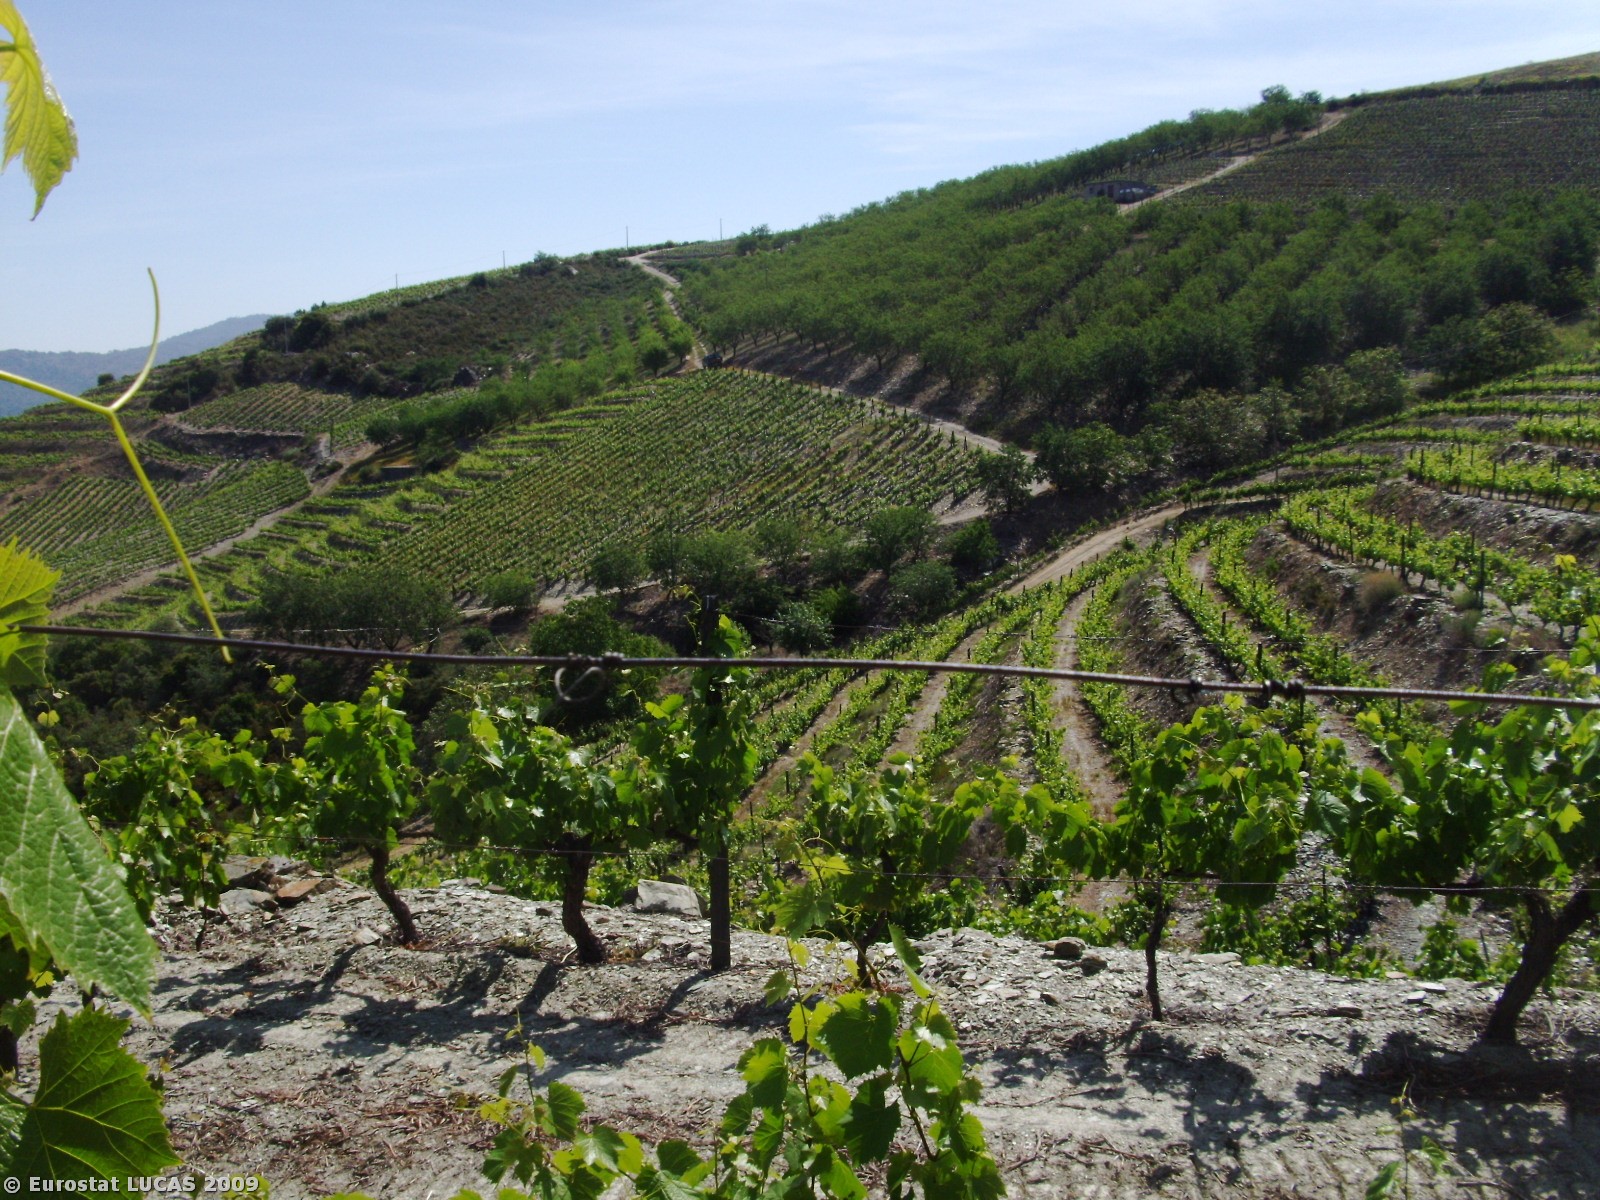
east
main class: Cropland
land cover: Vineyards
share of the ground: 10 - 25 %
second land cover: Bare land
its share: > 75 %
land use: Agriculture (excluding fallow land and kitchen gardens)
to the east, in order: Vineyards; Bare land; Vineyards; Bare land; Vineyards; Bare land; Vineyards; Bare land; Tracks; Olive groves; Tracks; Vineyards; Tracks; Artificial constructions in urban areas; Vineyards
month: May
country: PT
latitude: 41.1686
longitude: -7.4141
